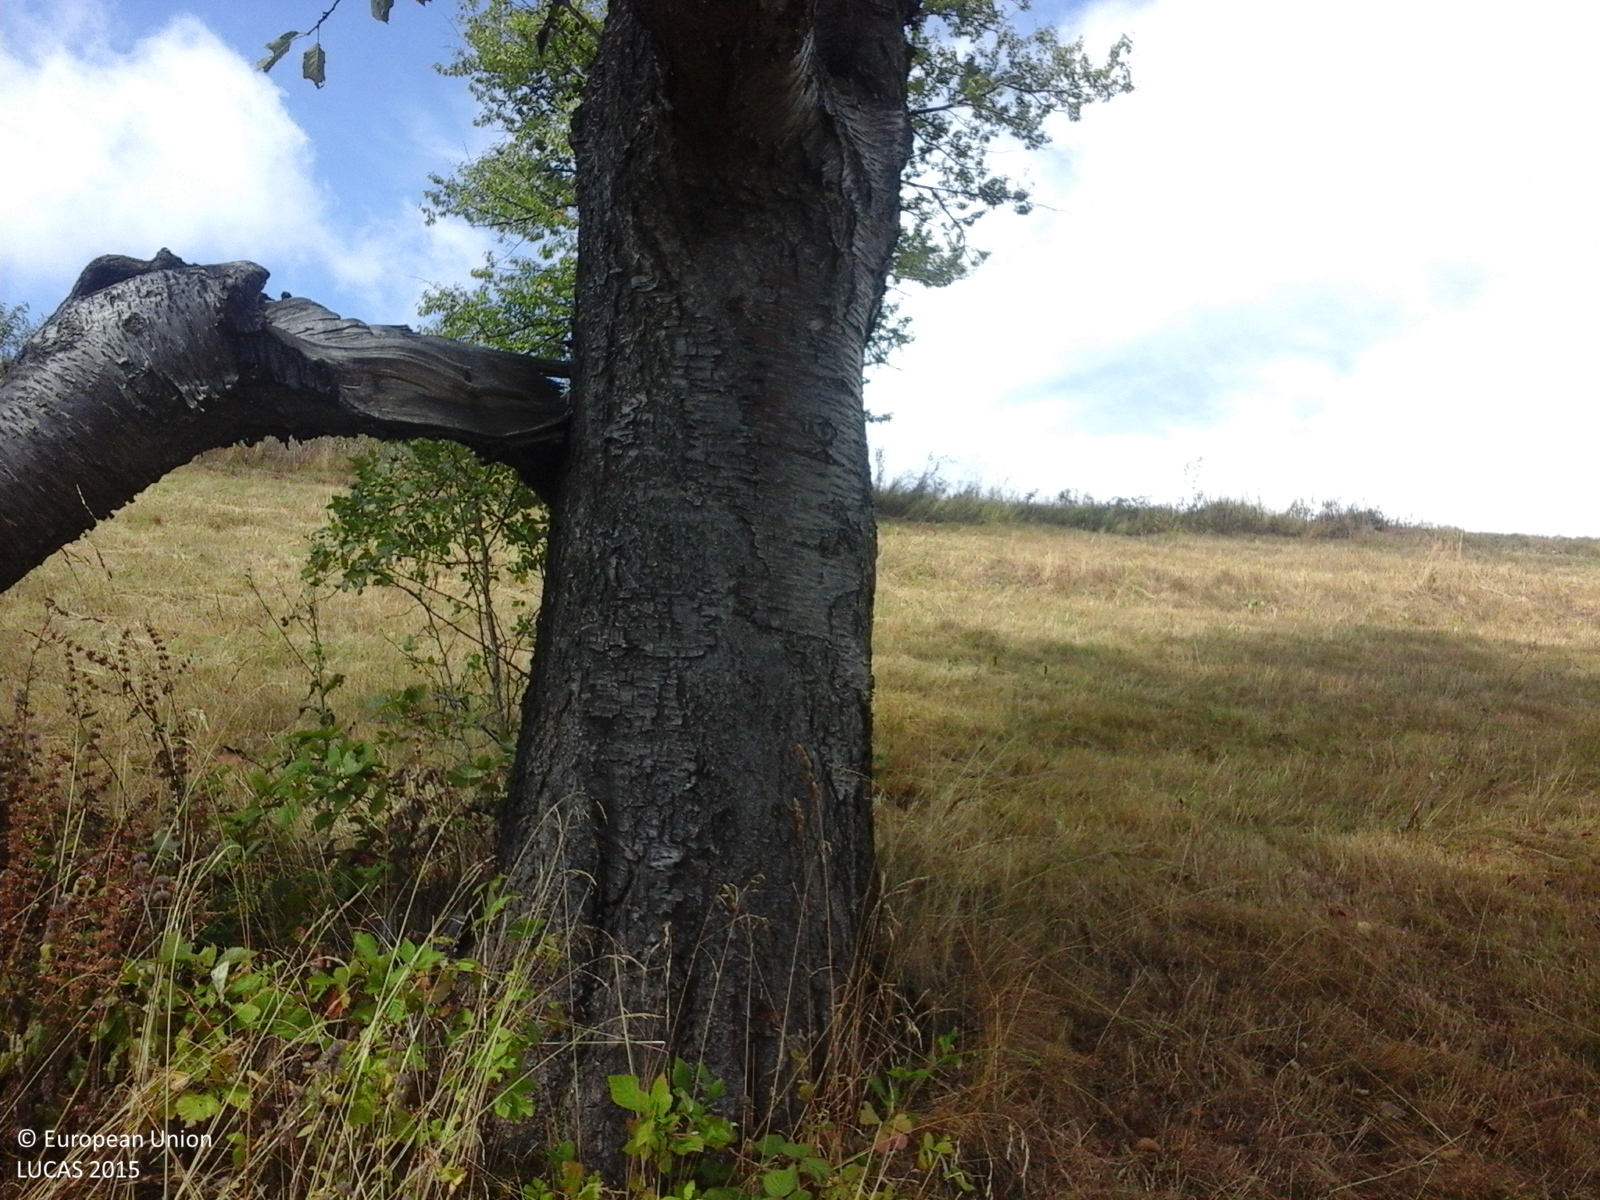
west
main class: Grassland
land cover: Grassland with sparse tree/shrub cover
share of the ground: > 75 %
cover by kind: herbaceous plants 85 %, shrubs 10 %, broadleaved forest trees 5 %
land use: Agriculture (excluding fallow land and kitchen gardens)
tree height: < 5 m
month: August
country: RO
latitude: 44.7950
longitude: 21.8768
